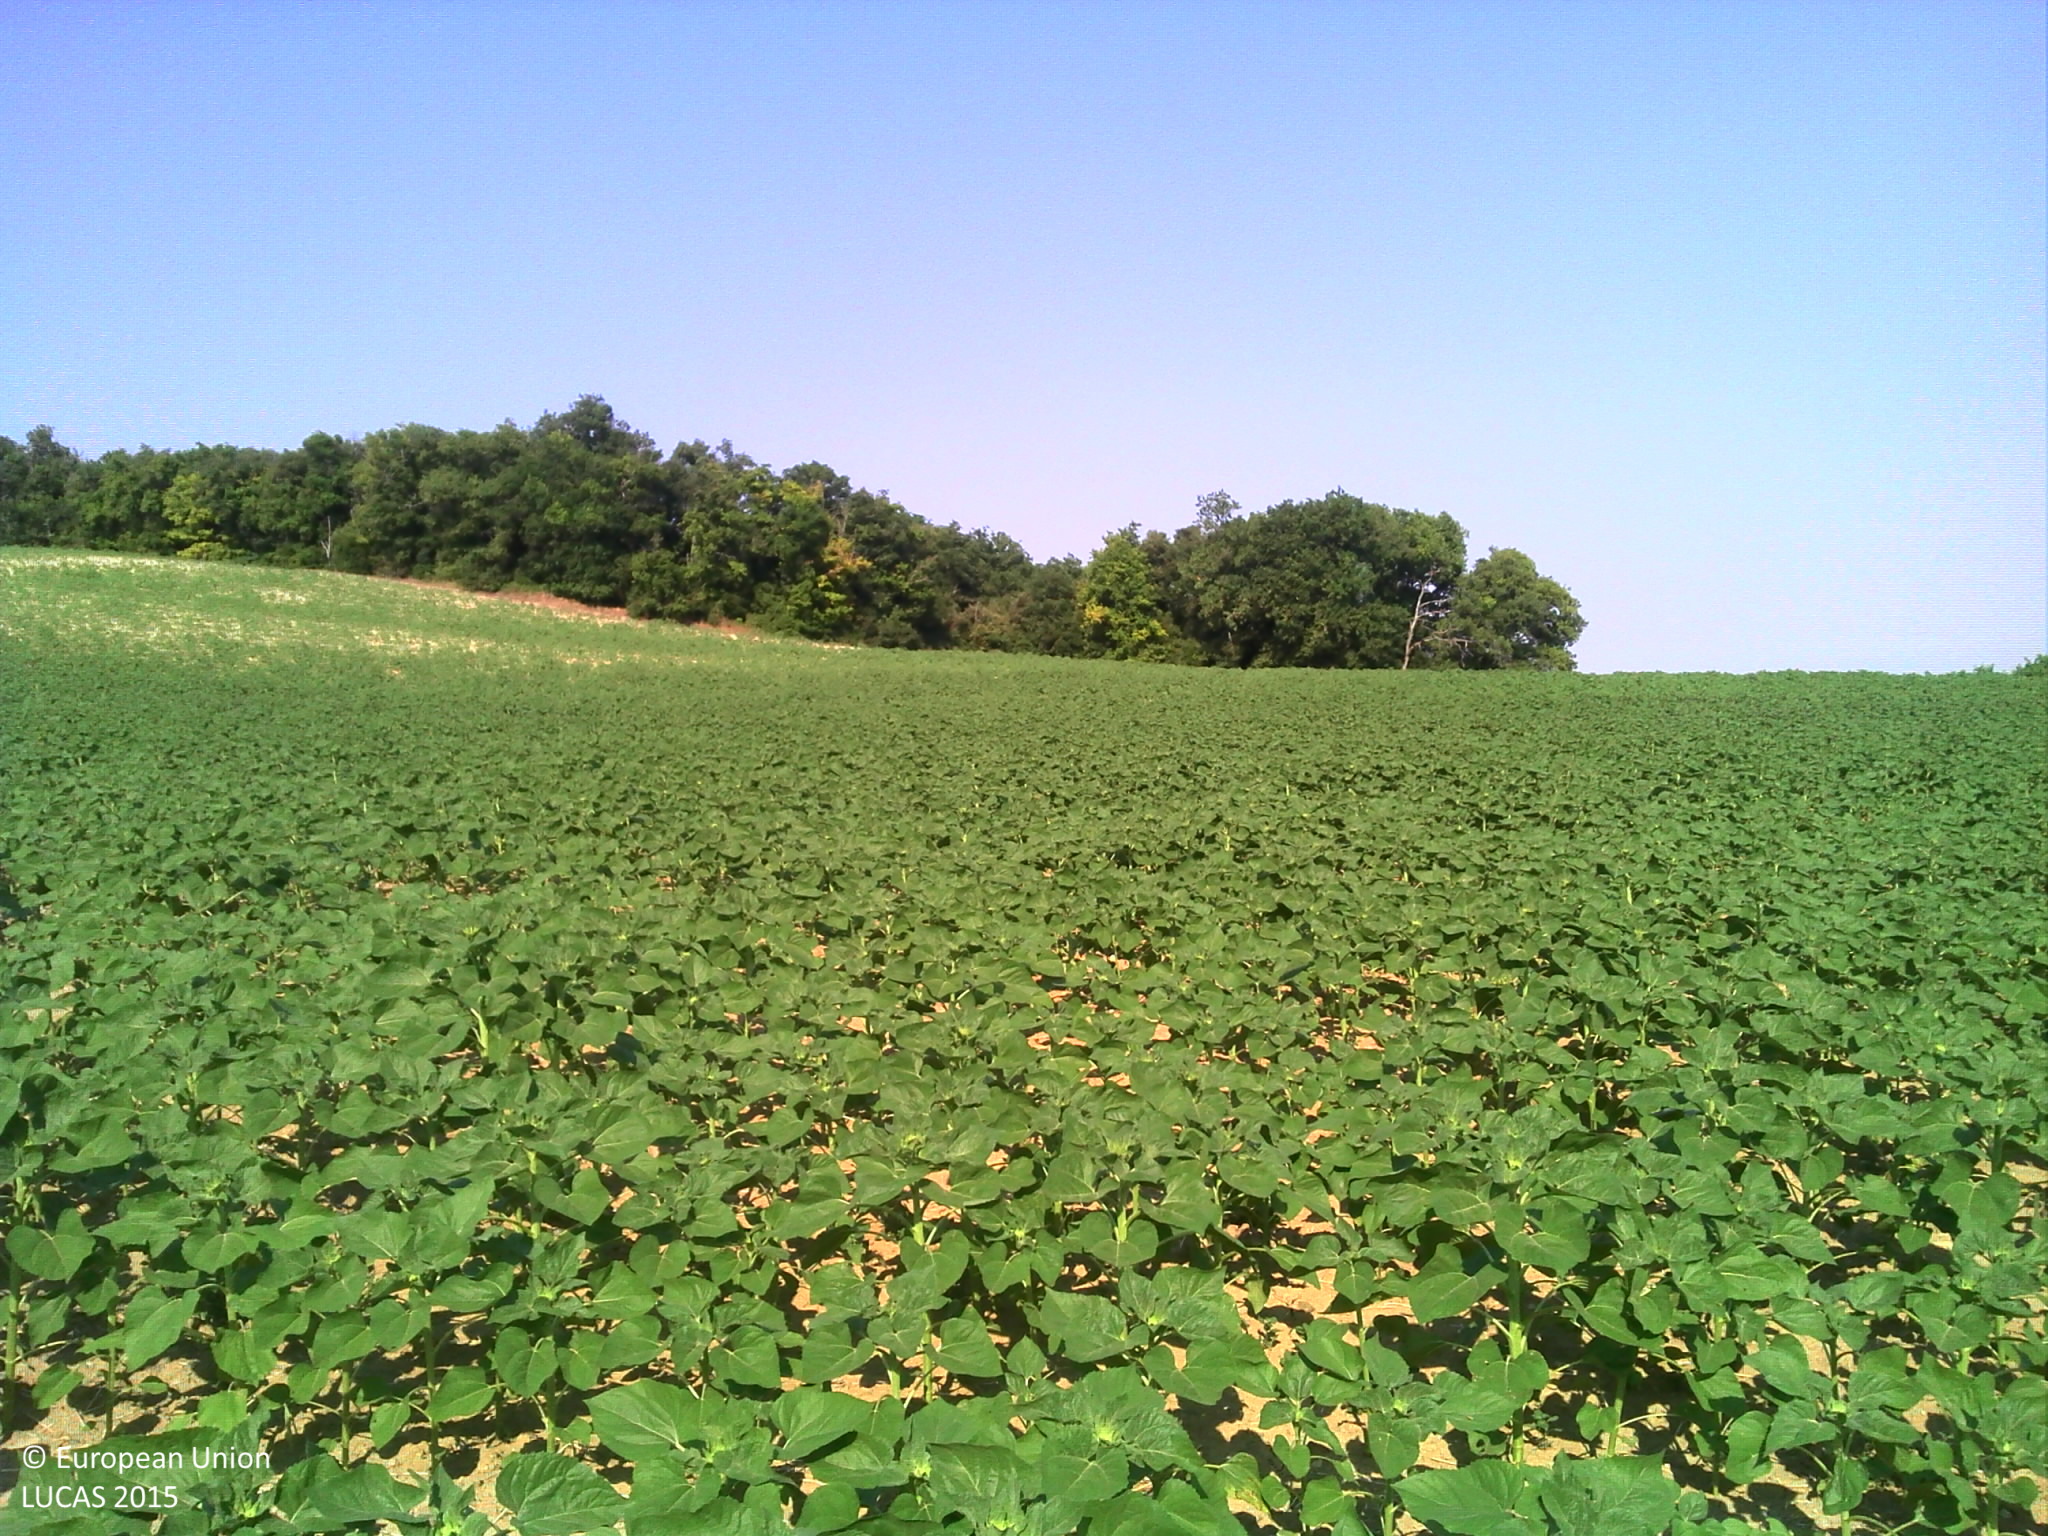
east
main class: Cropland
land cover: Sunflower
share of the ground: > 75 %
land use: Agriculture (excluding fallow land and kitchen gardens)
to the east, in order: Sunflower; Broadleaved woodland
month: June
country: FR
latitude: 43.1572
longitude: 2.0505
